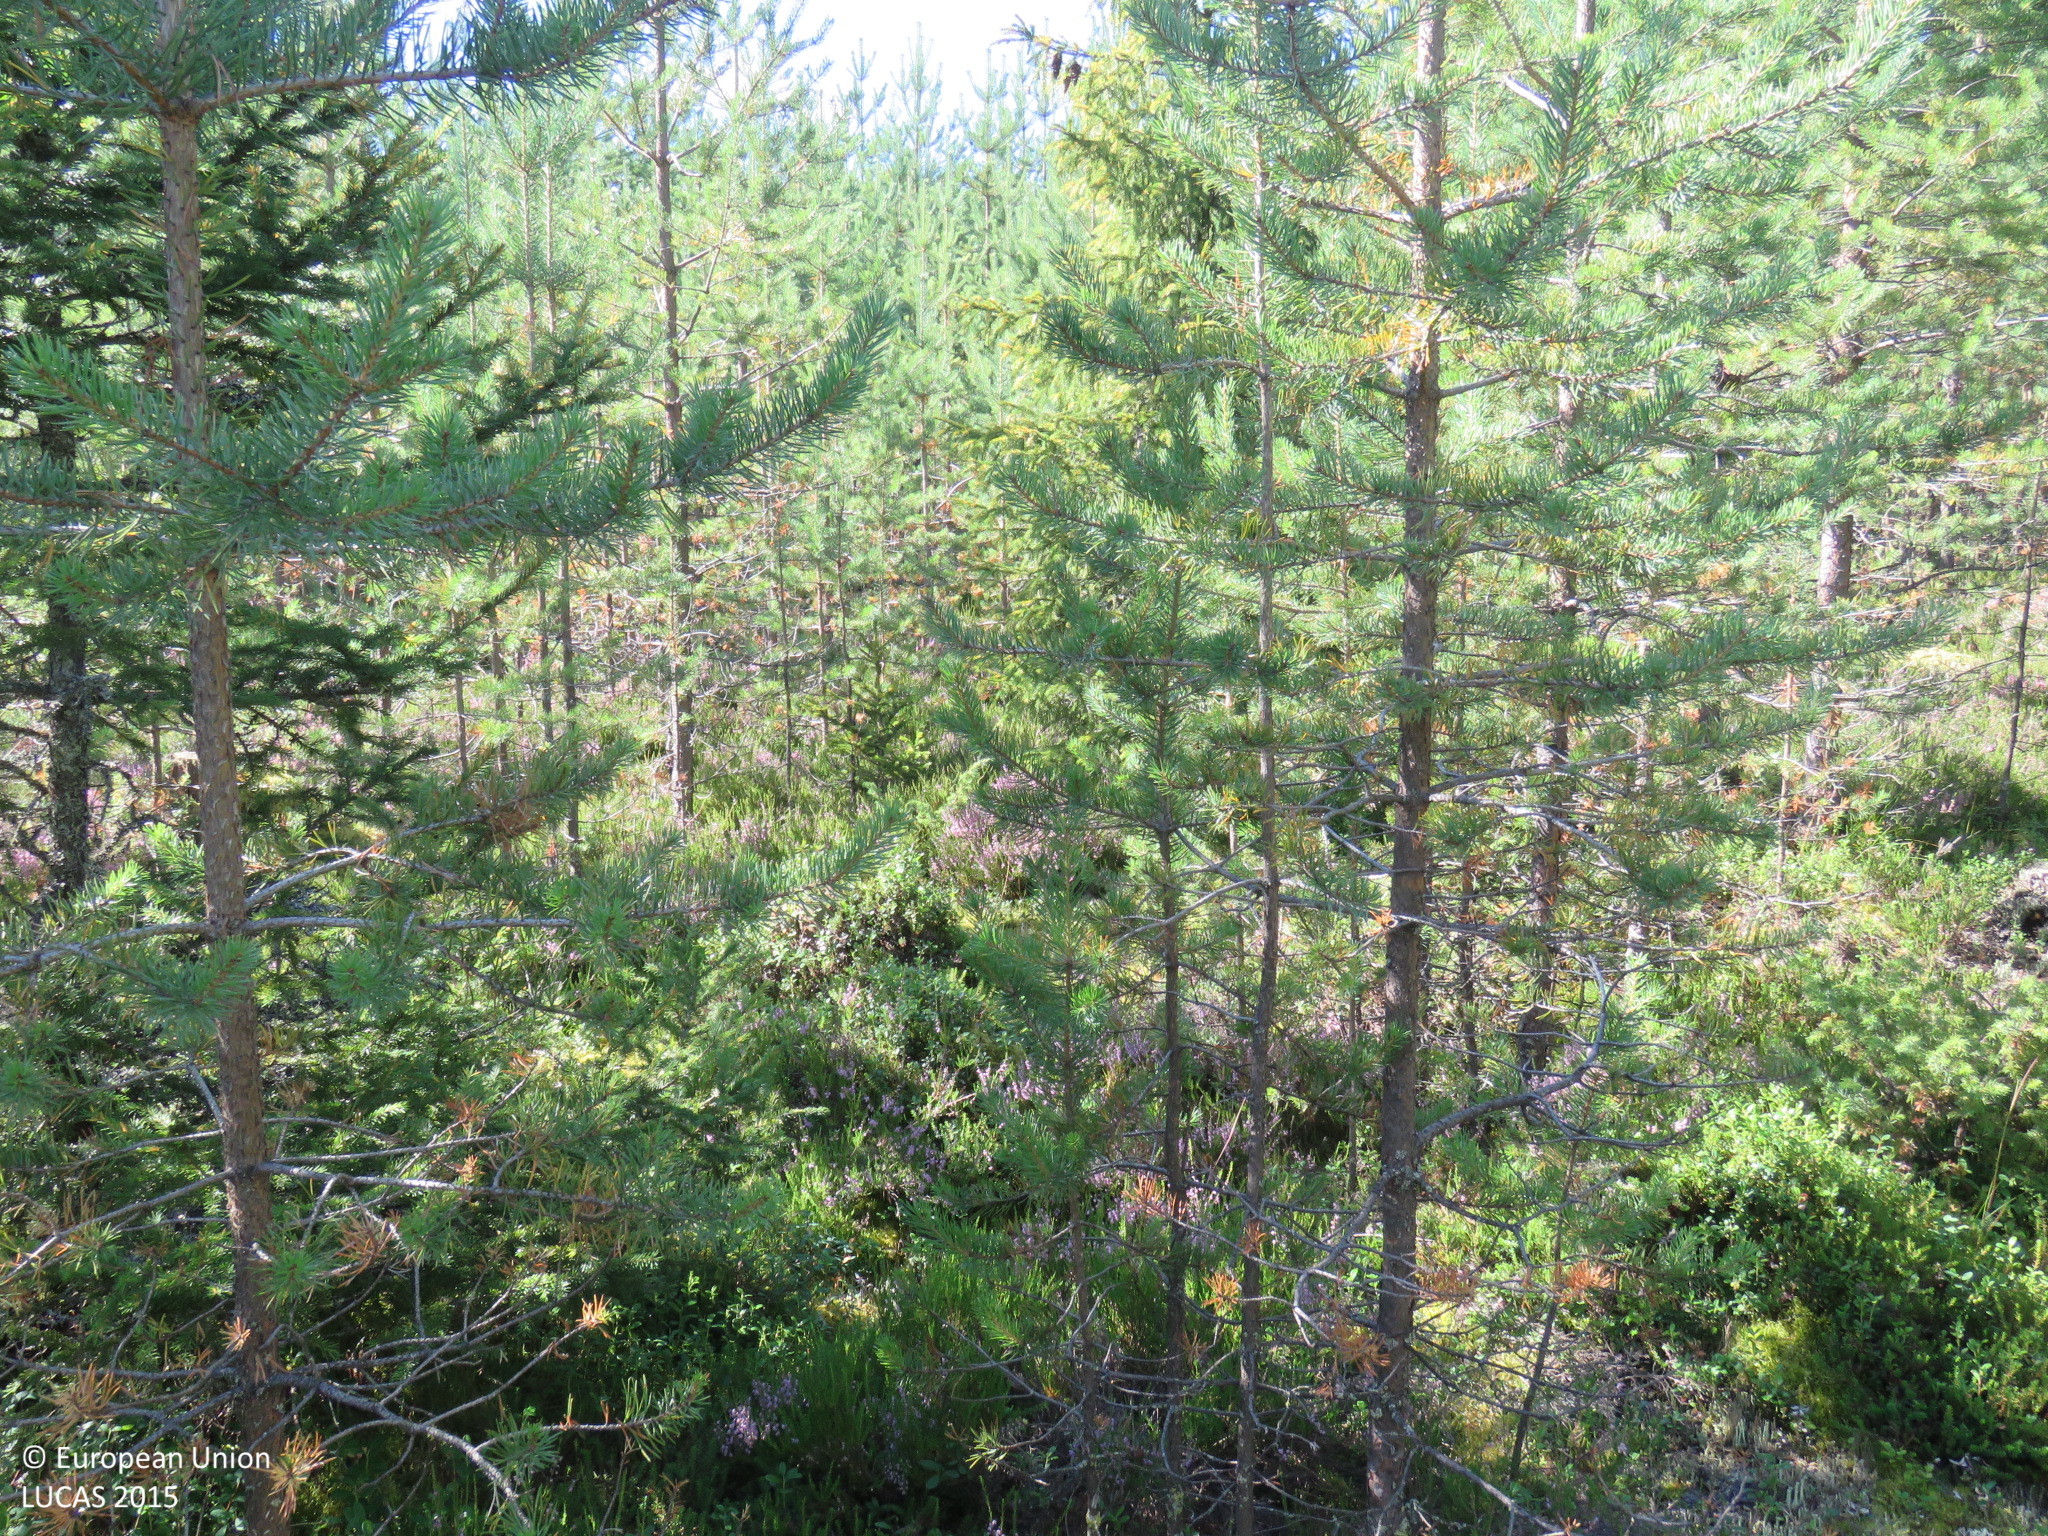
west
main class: Woodland
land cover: Pine dominated coniferous woodland
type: boreal forest
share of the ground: > 75 %
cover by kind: coniferous forest trees 85 %, shrubs 10 %, broadleaved forest trees 5 %
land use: Forestry
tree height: < 5 m
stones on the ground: < 10 %
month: August
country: FI
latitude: 65.1574
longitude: 25.7671
